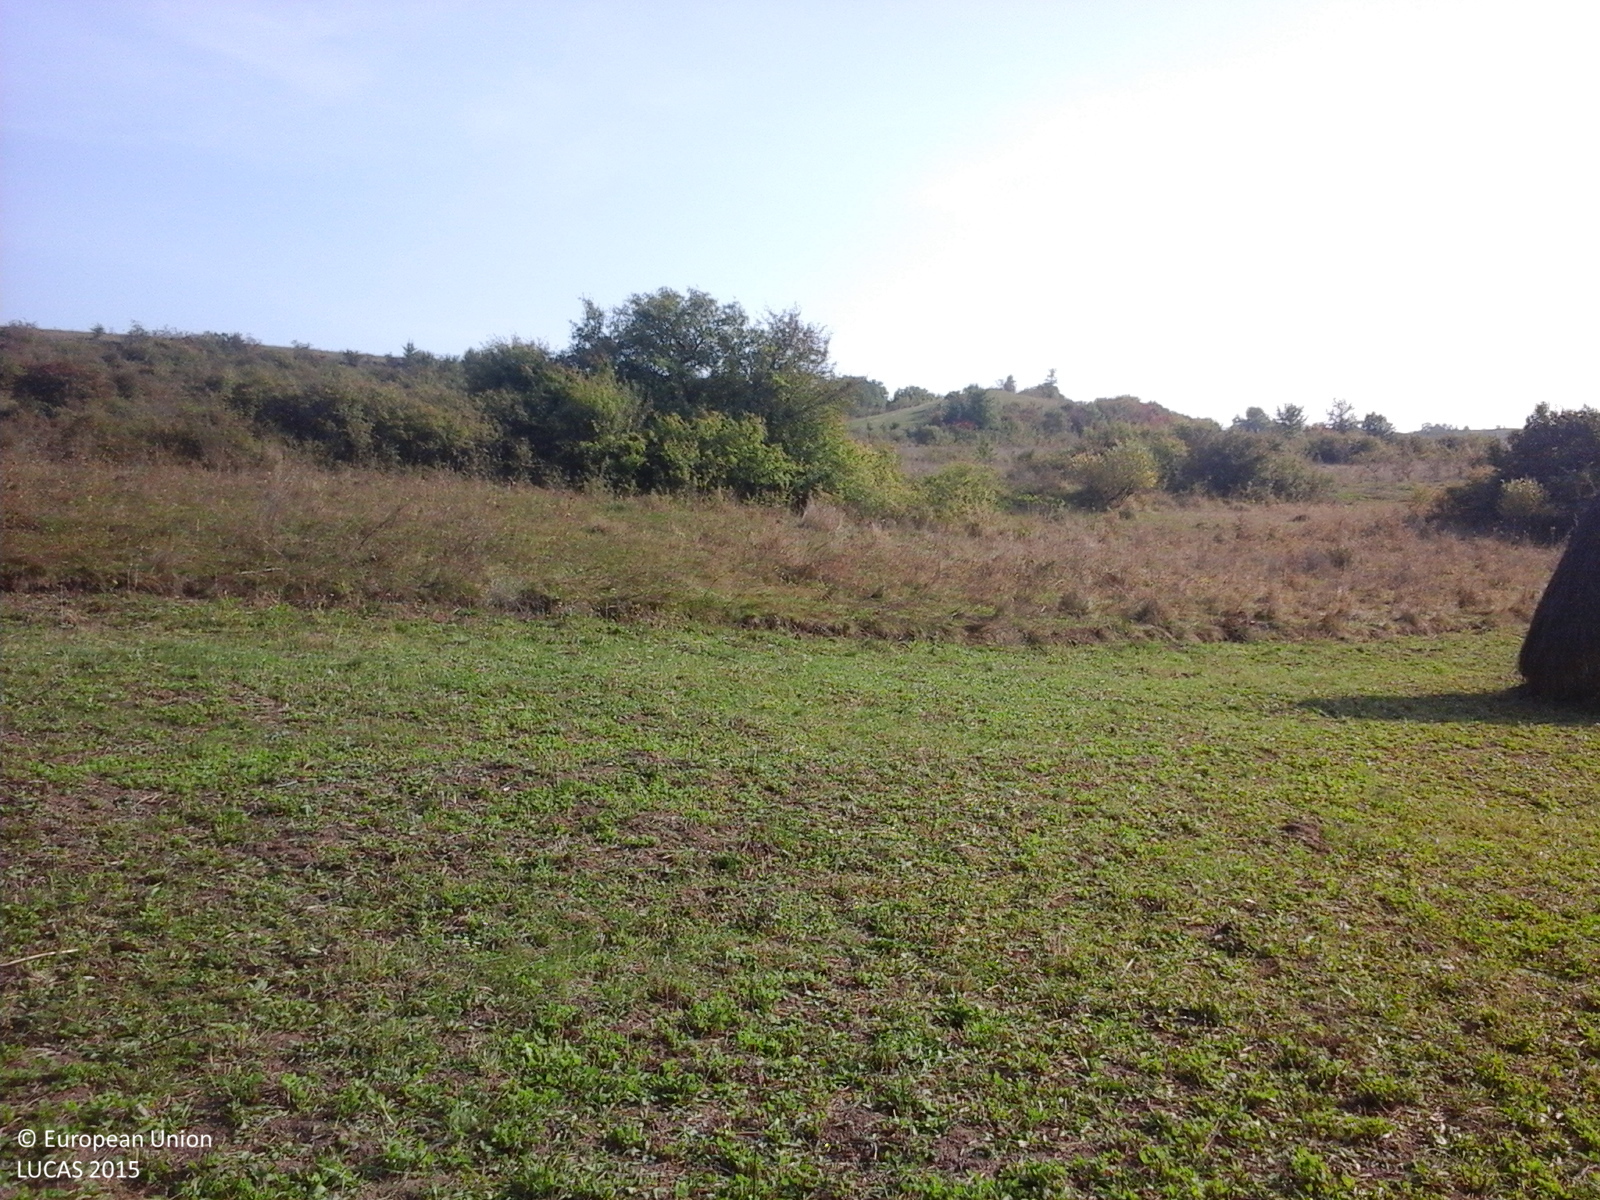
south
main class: Shrubland
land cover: Shrubland without tree cover
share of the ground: > 75 %
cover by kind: shrubs 100 %
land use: Fallow land
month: September
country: RO
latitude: 47.0040
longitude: 23.3652
